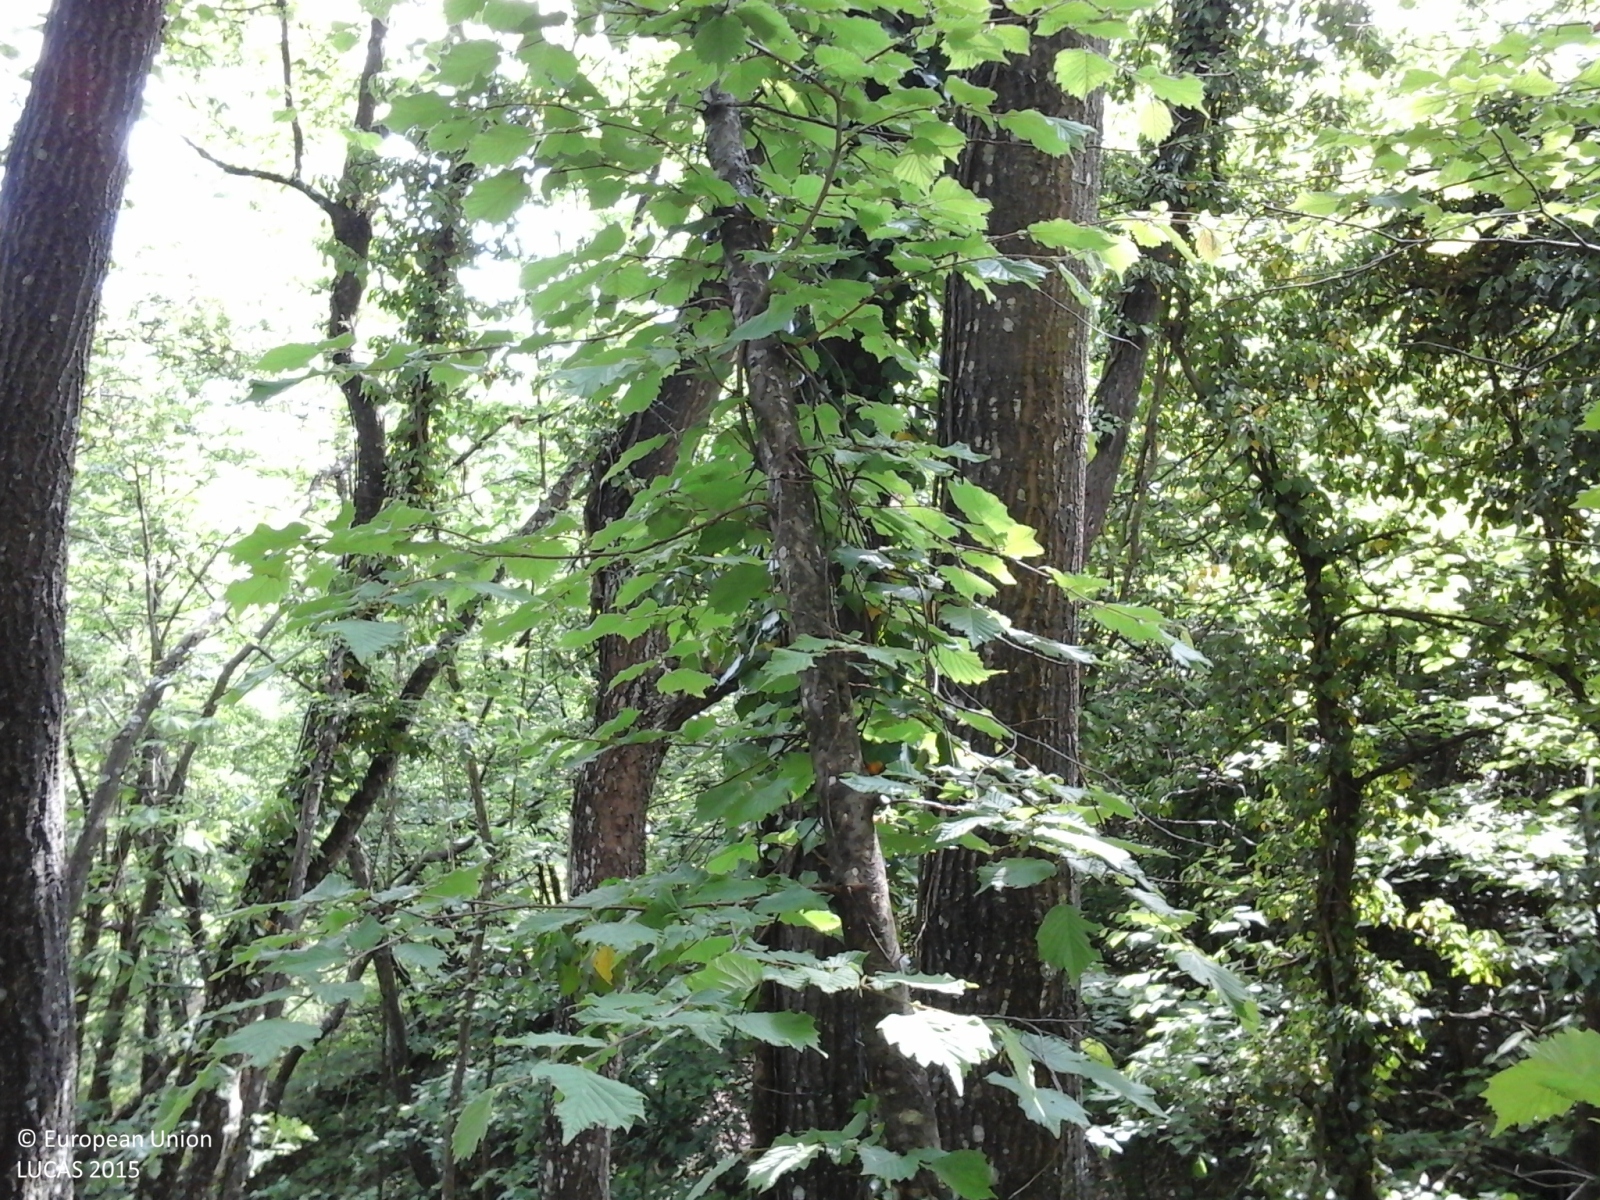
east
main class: Woodland
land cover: Broadleaved woodland
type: thermophilous deciduous forest
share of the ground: > 75 %
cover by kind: broadleaved forest trees 95 %, shrubs 5 %
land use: Forestry
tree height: > 5 m
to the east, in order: Broadleaved woodland; Ditches and canals; Broadleaved woodland; Lucerne; Broadleaved woodland
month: May
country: IT
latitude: 44.5128
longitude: 10.1130
